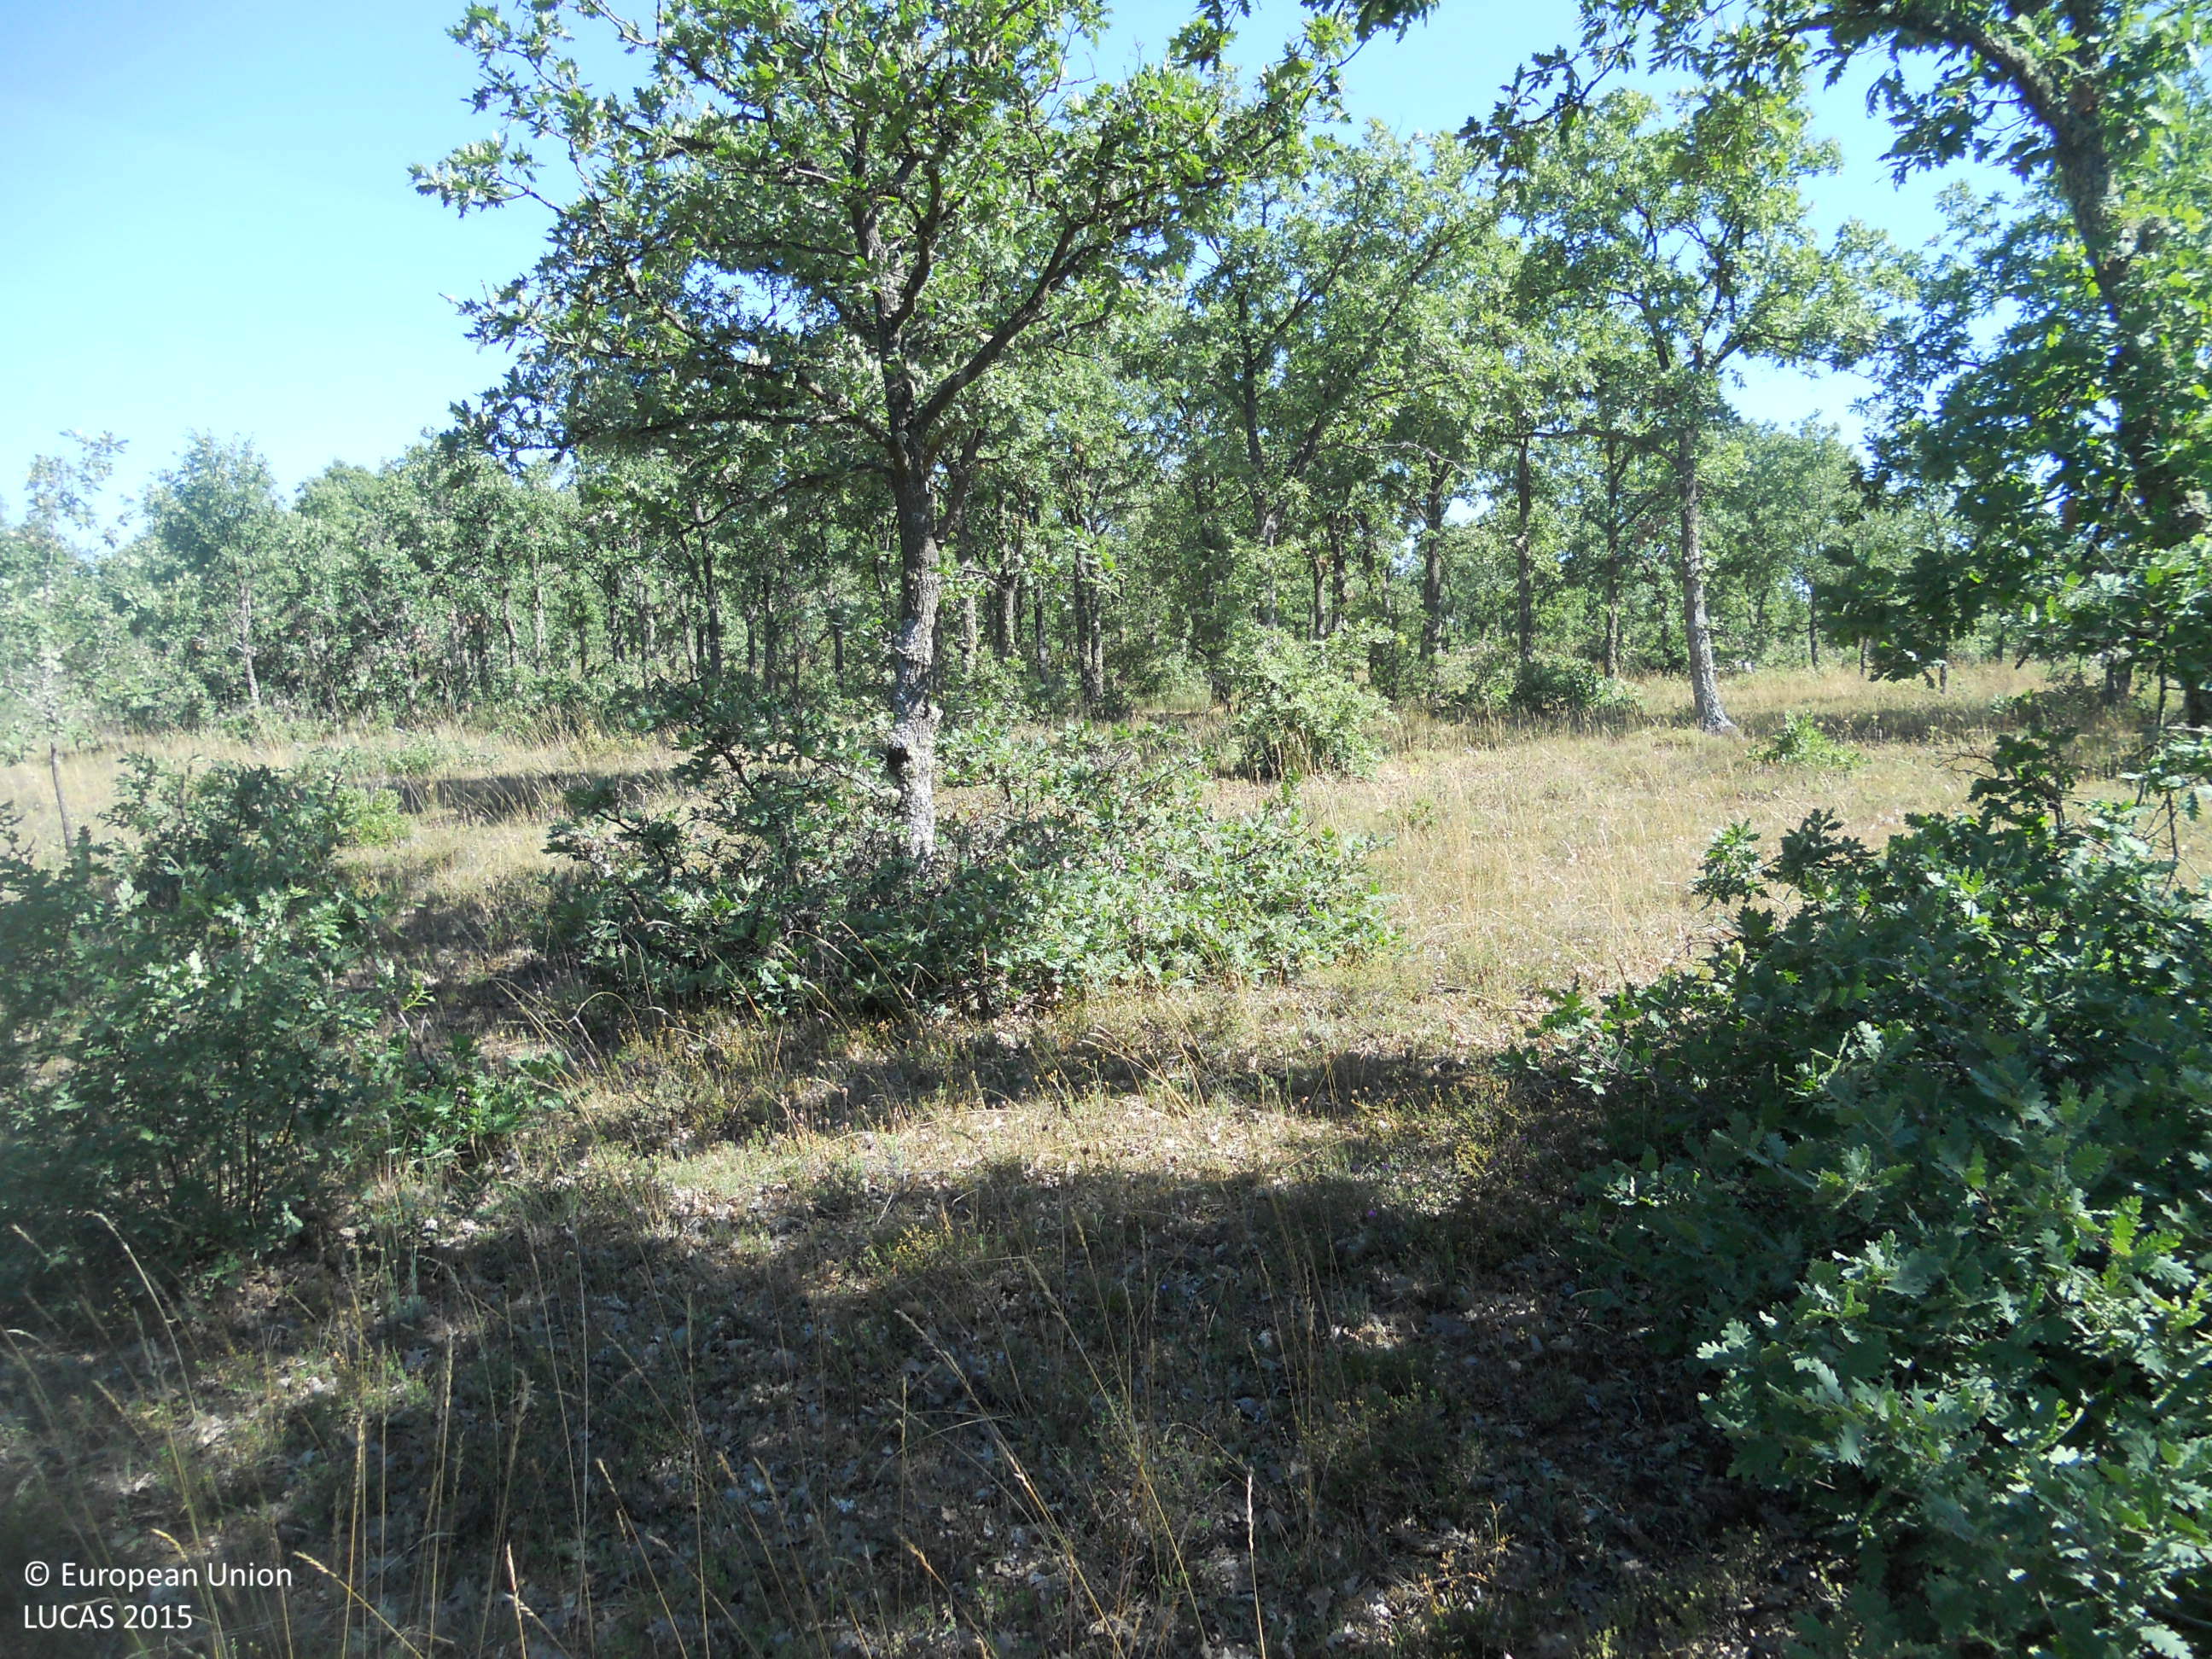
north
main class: Woodland
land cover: Broadleaved woodland
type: thermophilous deciduous forest
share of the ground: 50 - 75 %
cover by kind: herbaceous plants 55 %, broadleaved forest trees 45 %
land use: Forestry
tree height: > 5 m
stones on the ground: > 50 %
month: June
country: ES
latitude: 42.3898
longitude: -4.8886
